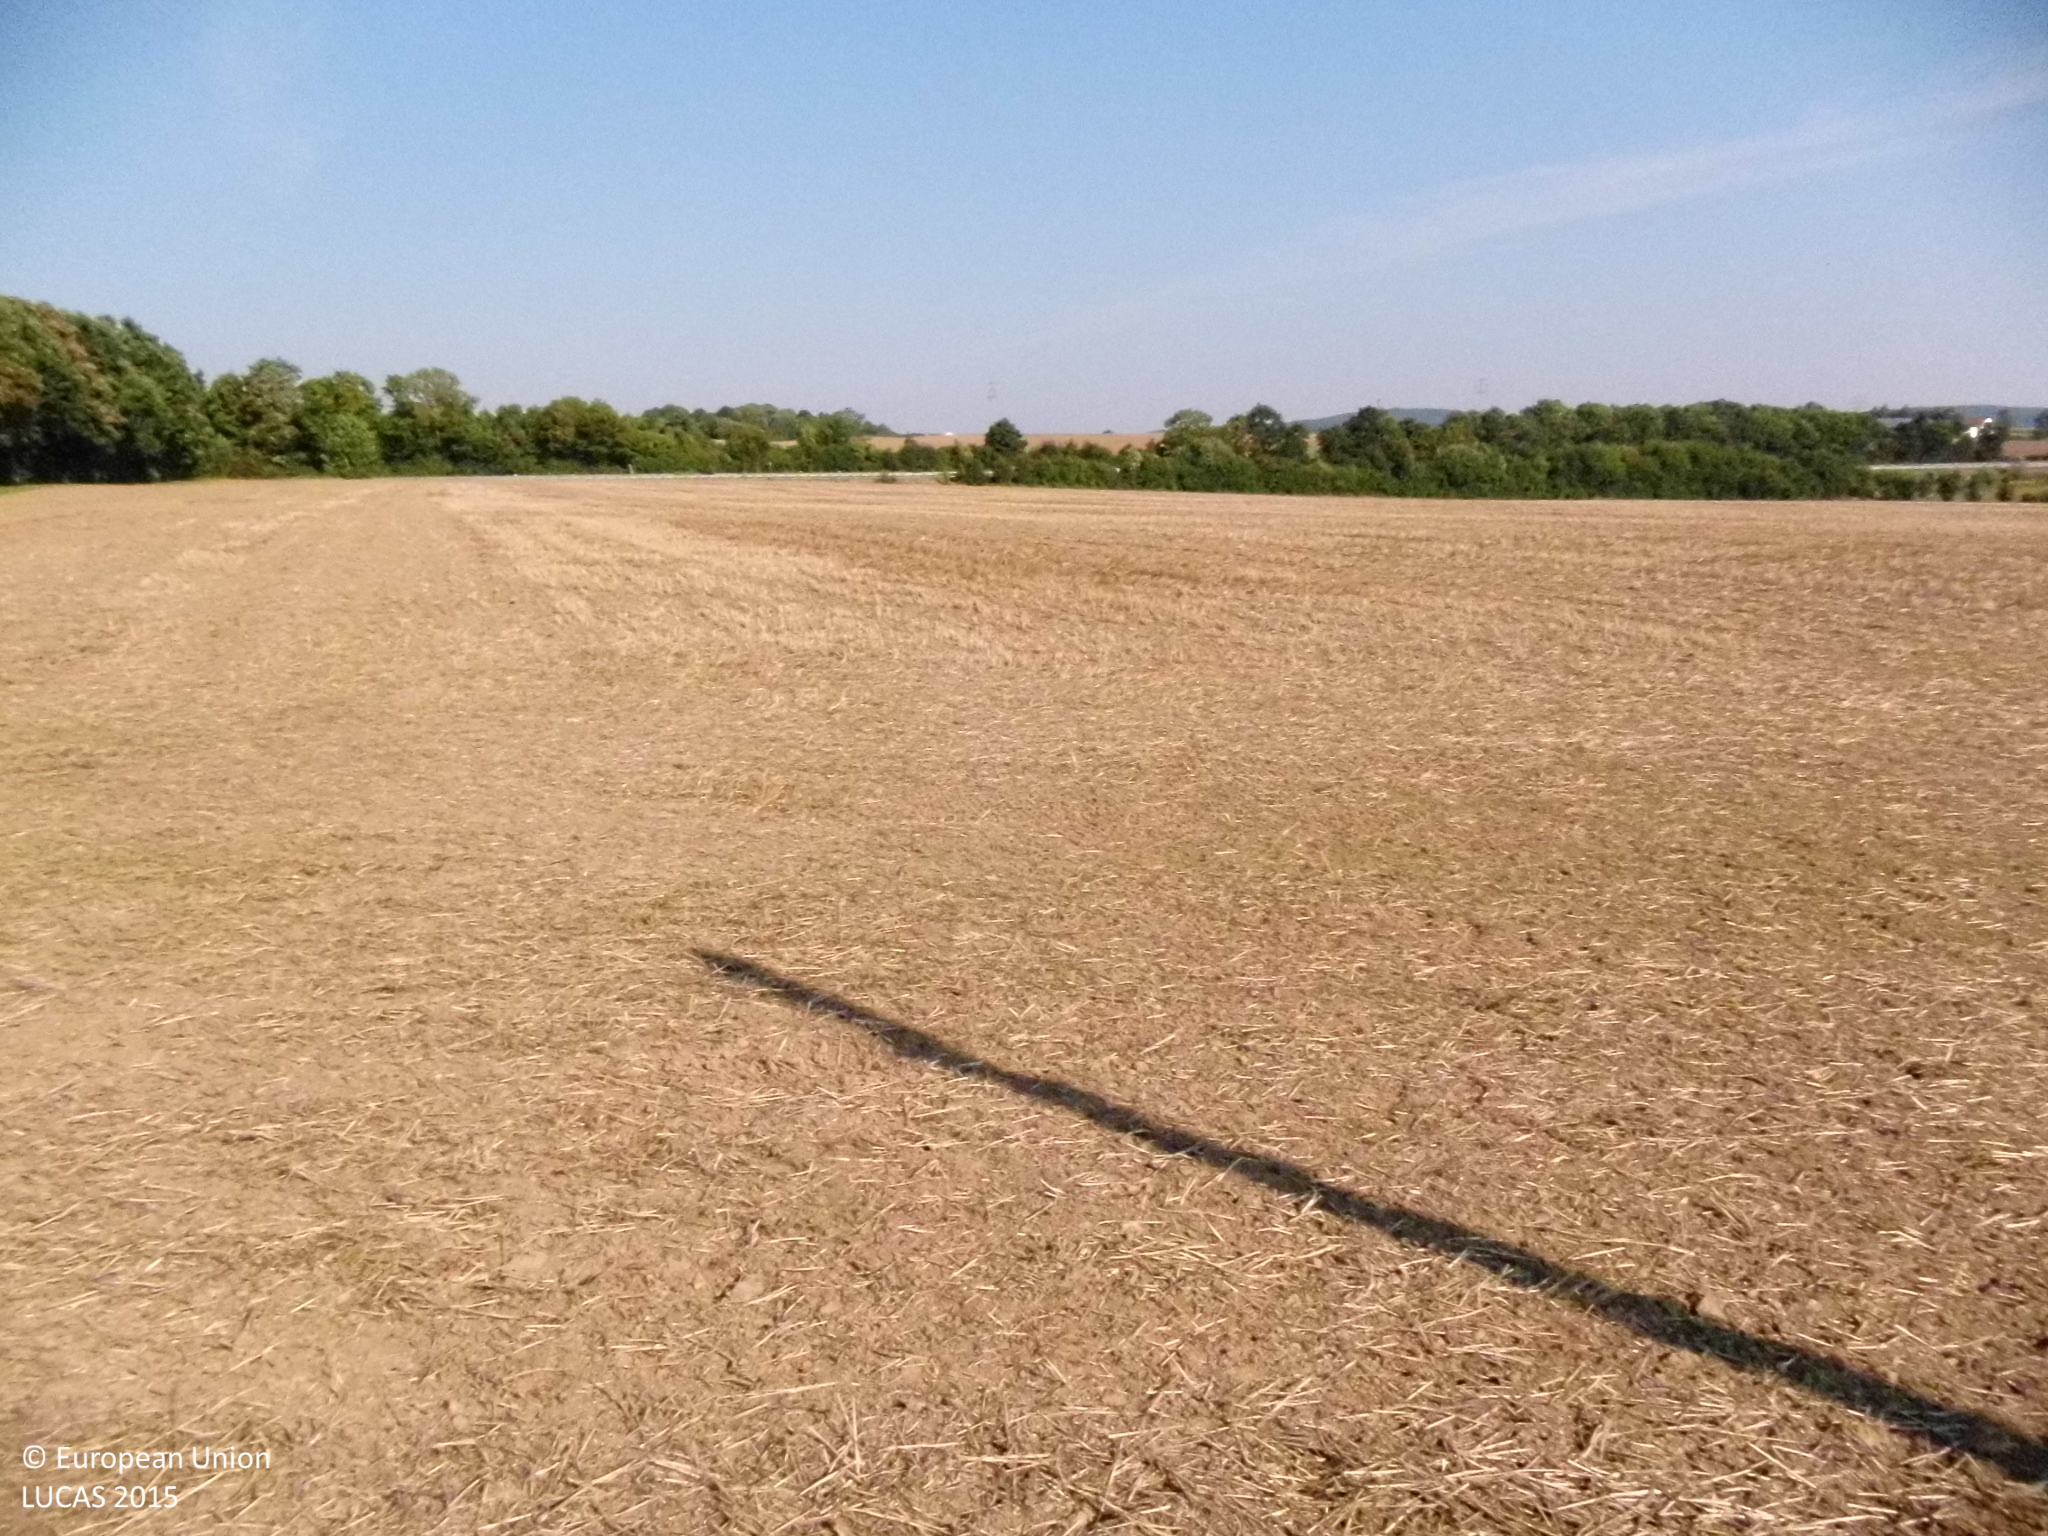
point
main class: Cropland
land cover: Common wheat
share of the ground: < 10 %
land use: Agriculture (excluding fallow land and kitchen gardens)
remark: Tilled/Sowed
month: August
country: DE
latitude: 50.4382
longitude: 8.0996
